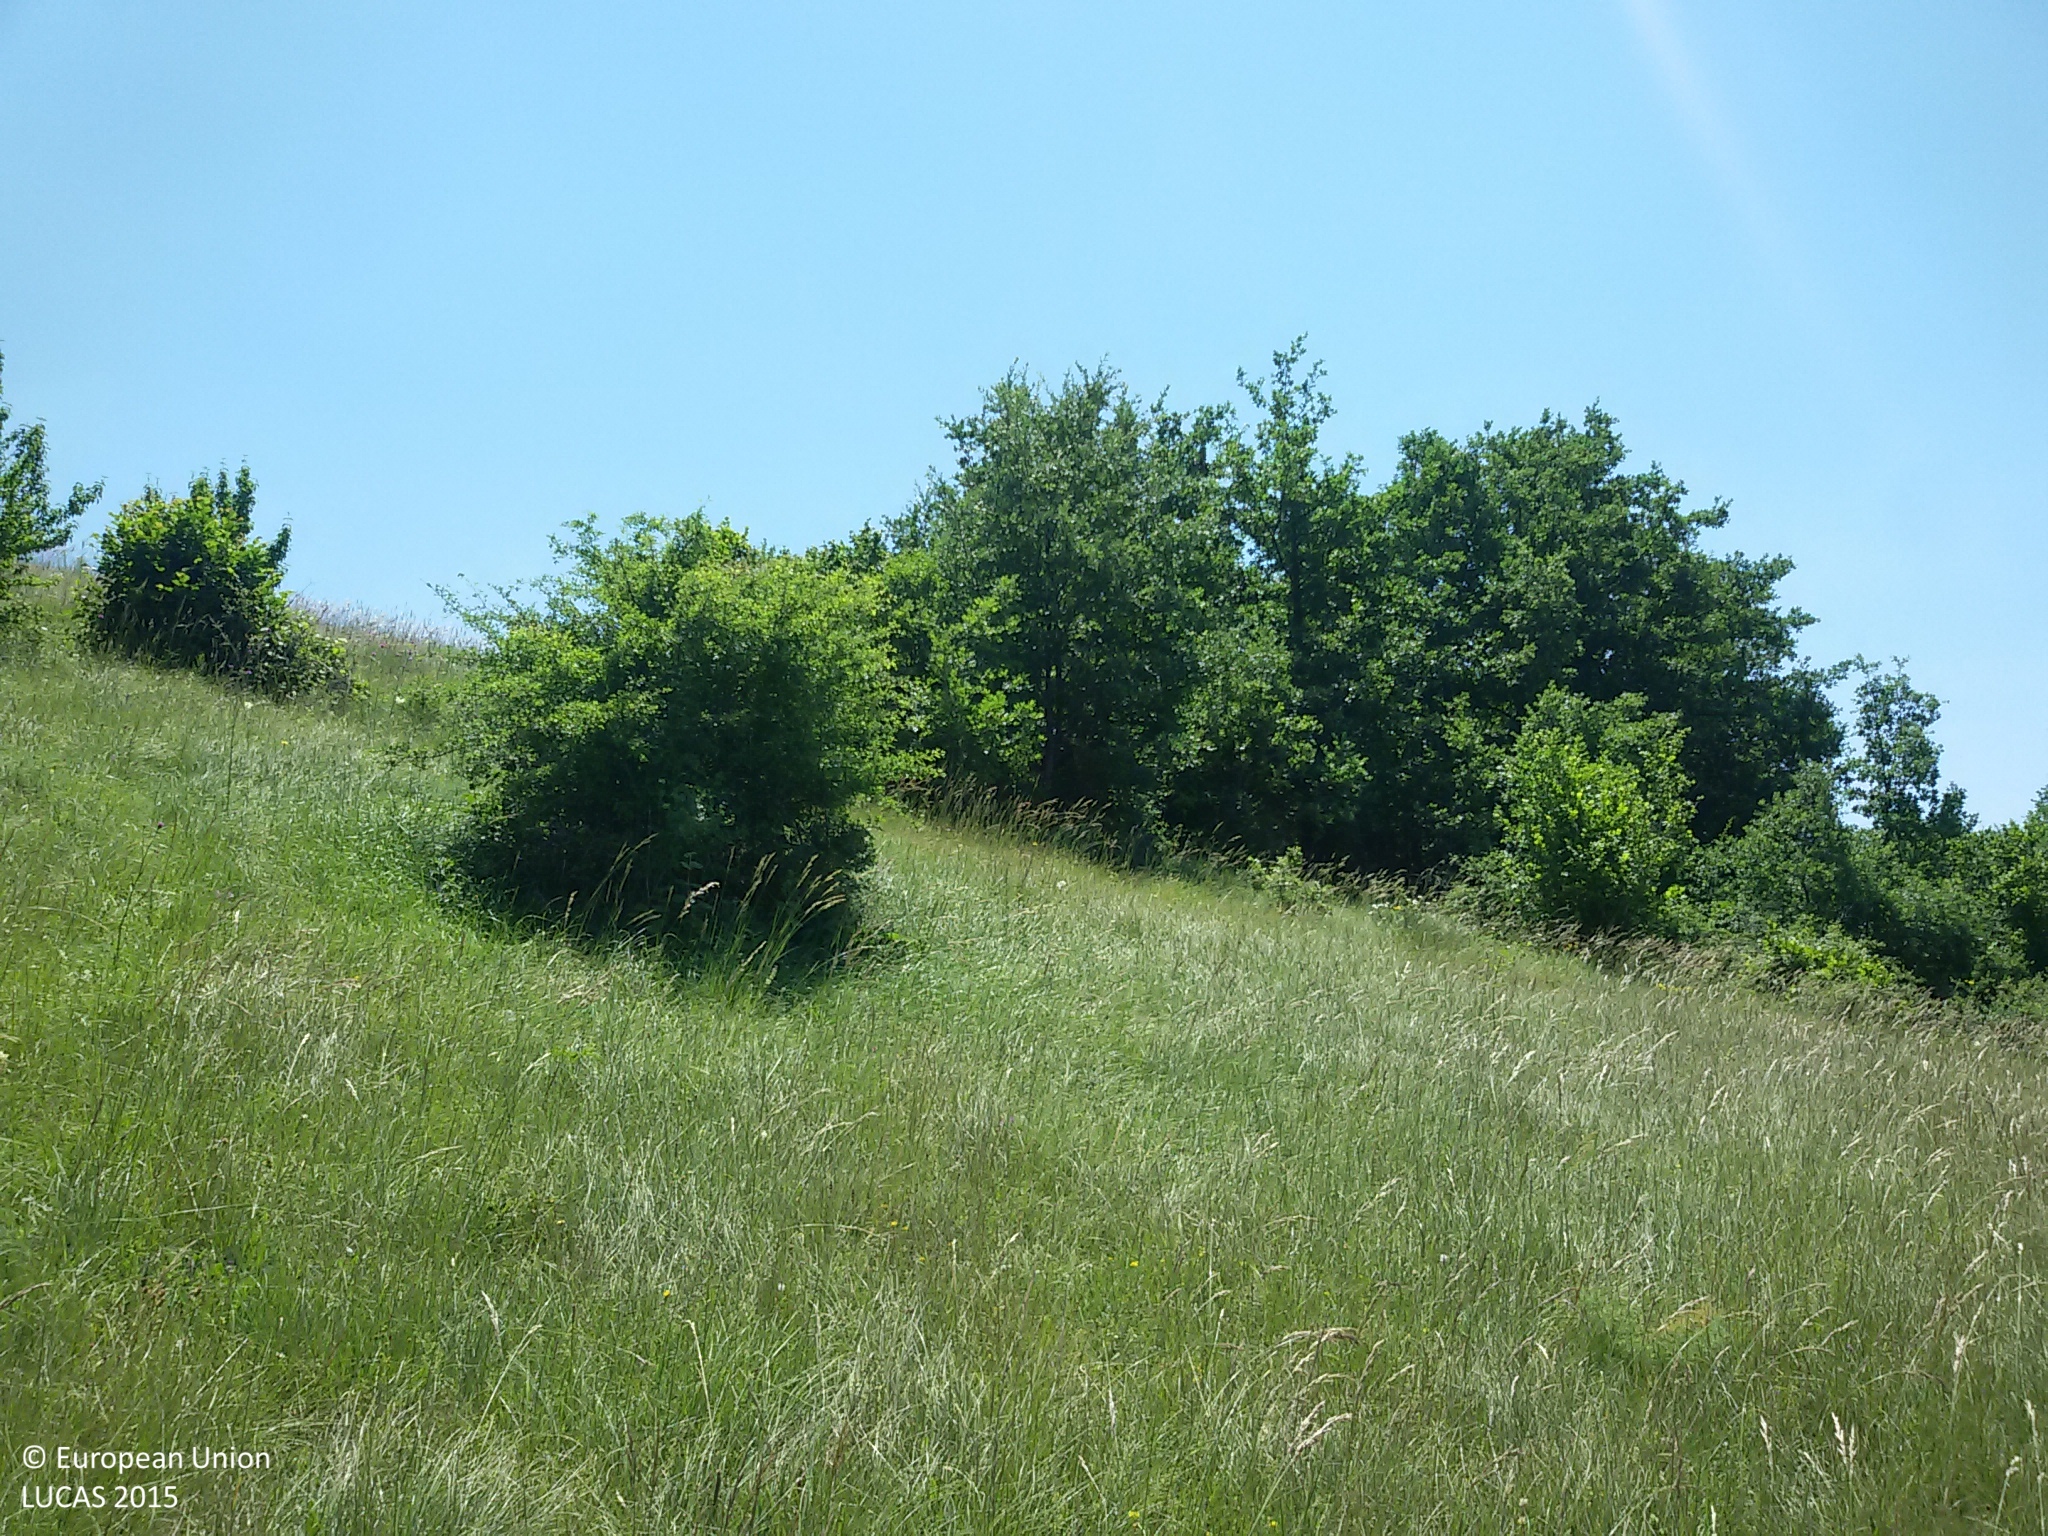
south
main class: Woodland
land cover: Broadleaved woodland
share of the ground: 10 - 25 %
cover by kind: herbaceous plants 55 %, broadleaved forest trees 25 %, shrubs 15 %, unconsolidated bare surface 5 %
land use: Semi-natural and natural areas not in use
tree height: < 5 m
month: June
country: HR
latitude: 44.4989
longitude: 15.7411
